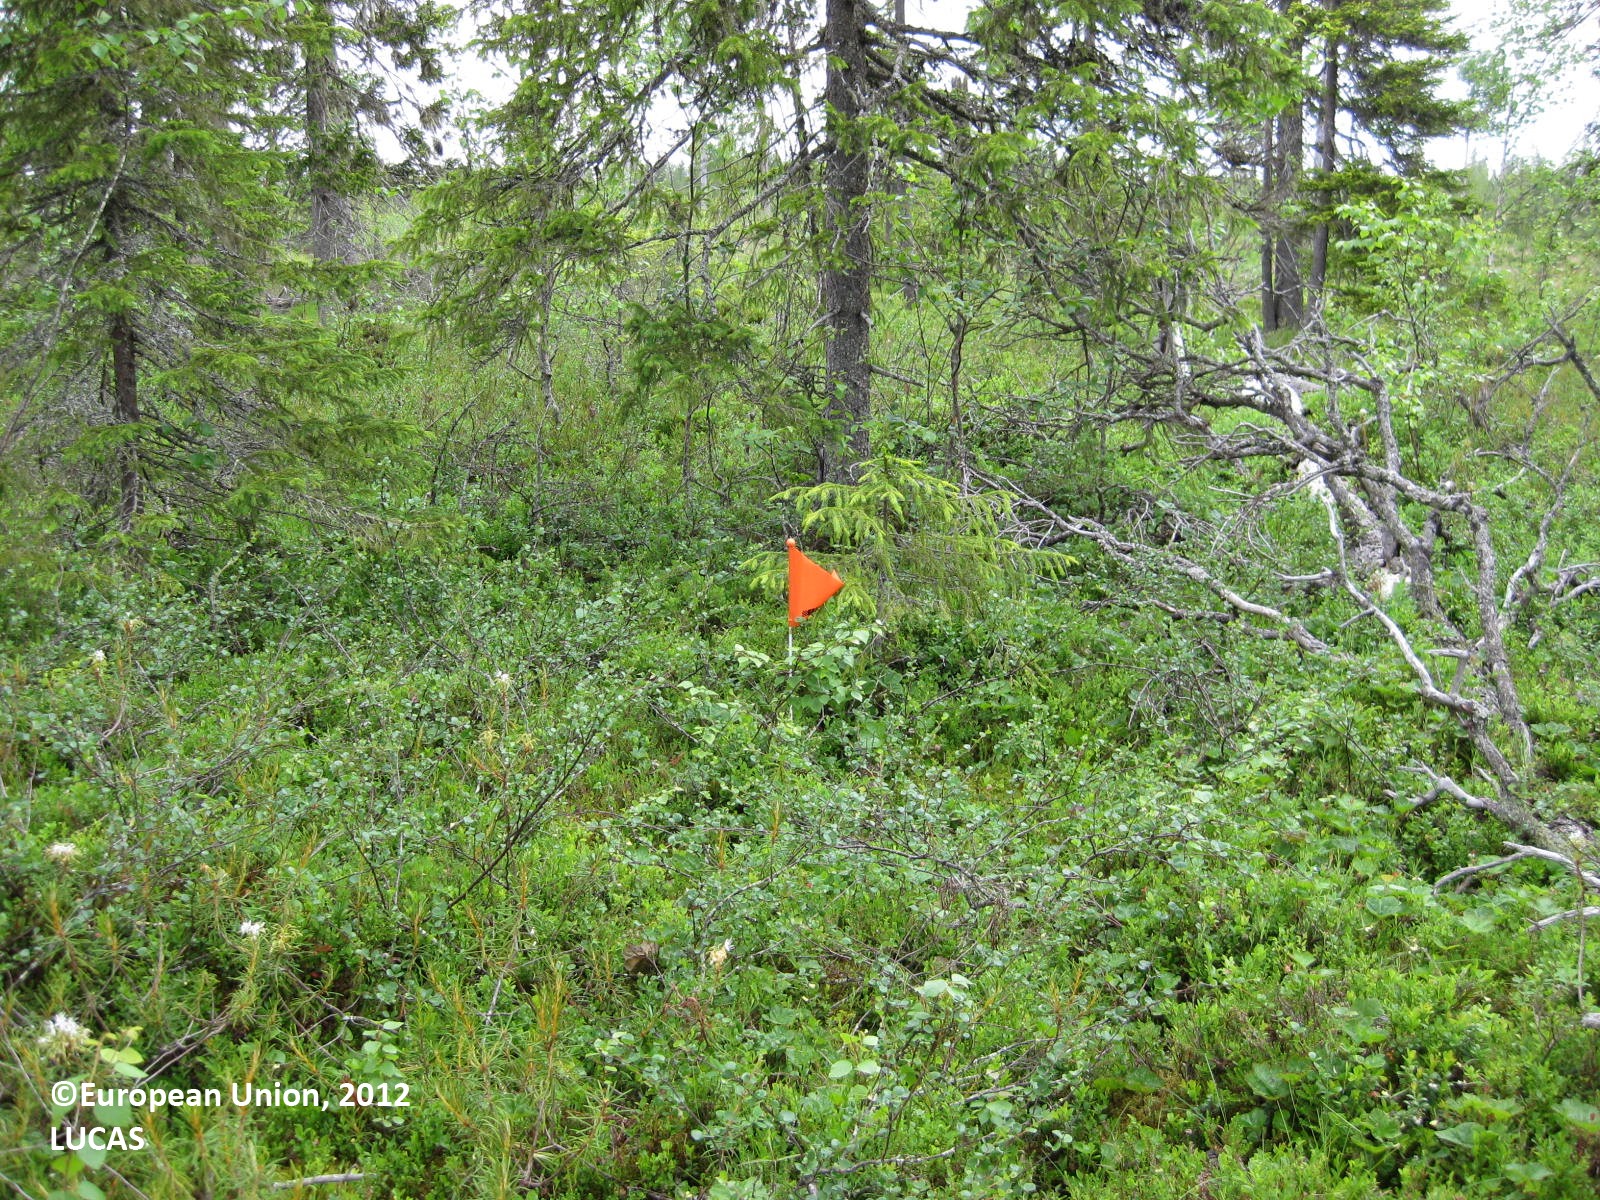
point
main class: Woodland
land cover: Spruce dominated coniferous woodland
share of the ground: 25 - 50 %
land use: Forestry
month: July
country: FI
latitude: 65.4562
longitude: 28.3894
